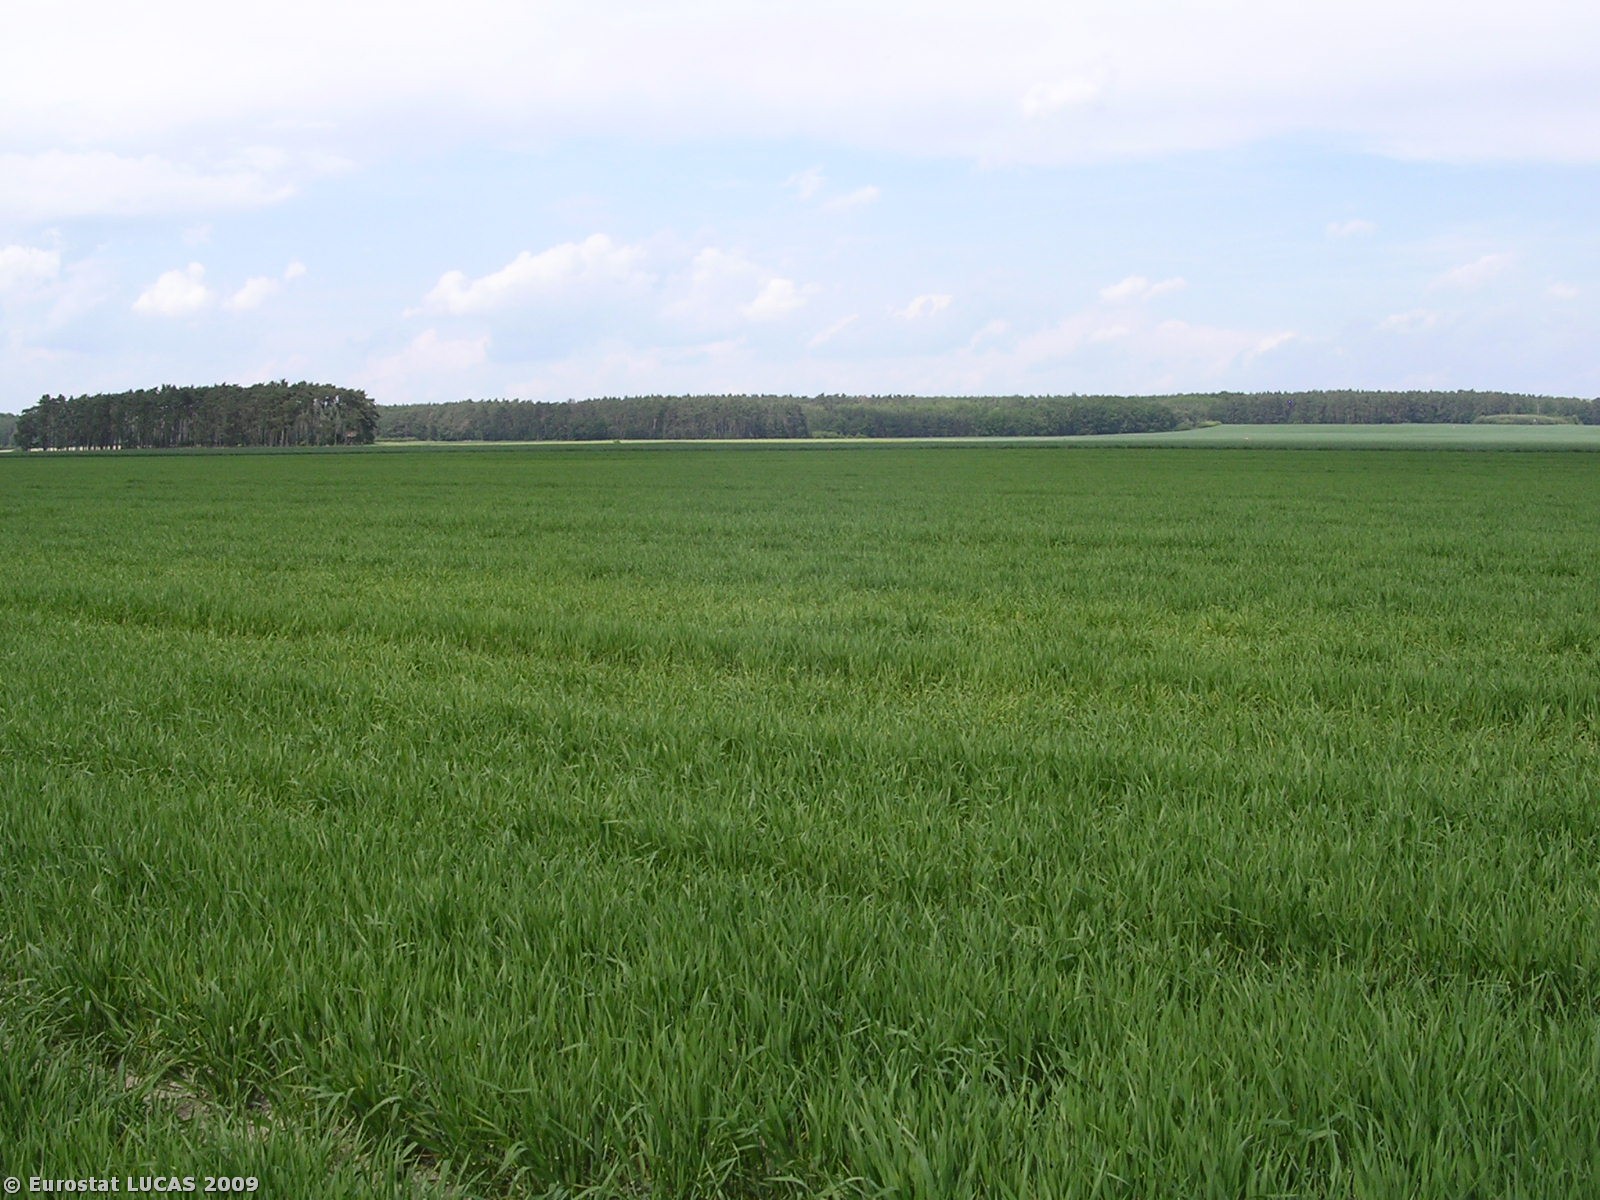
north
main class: Cropland
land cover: Barley
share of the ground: > 75 %
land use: Agriculture (excluding fallow land and kitchen gardens)
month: May
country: CZ
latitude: 50.2674
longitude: 14.7020
